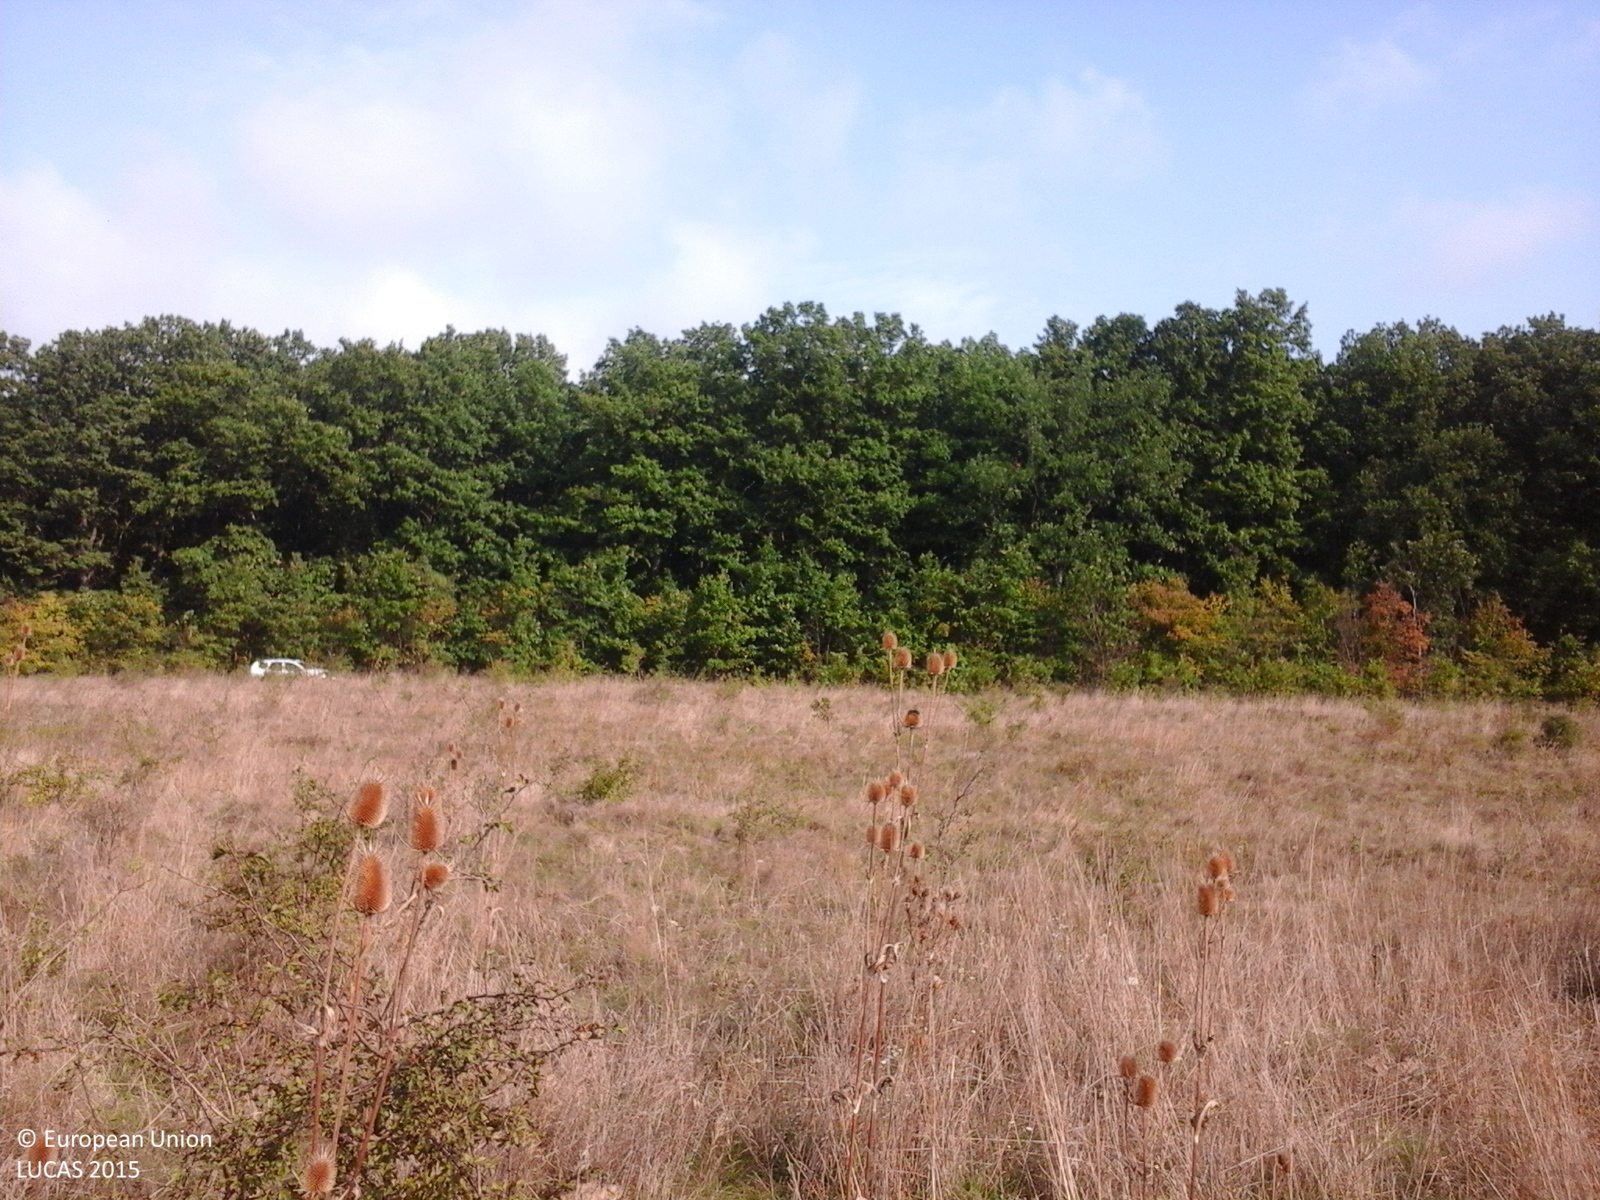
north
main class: Grassland
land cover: Grassland with sparse tree/shrub cover
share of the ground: > 75 %
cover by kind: herbaceous plants 85 %, shrubs 10 %, broadleaved forest trees 5 %
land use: Fallow land
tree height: < 5 m
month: September
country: RO
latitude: 45.9449
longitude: 22.7844
